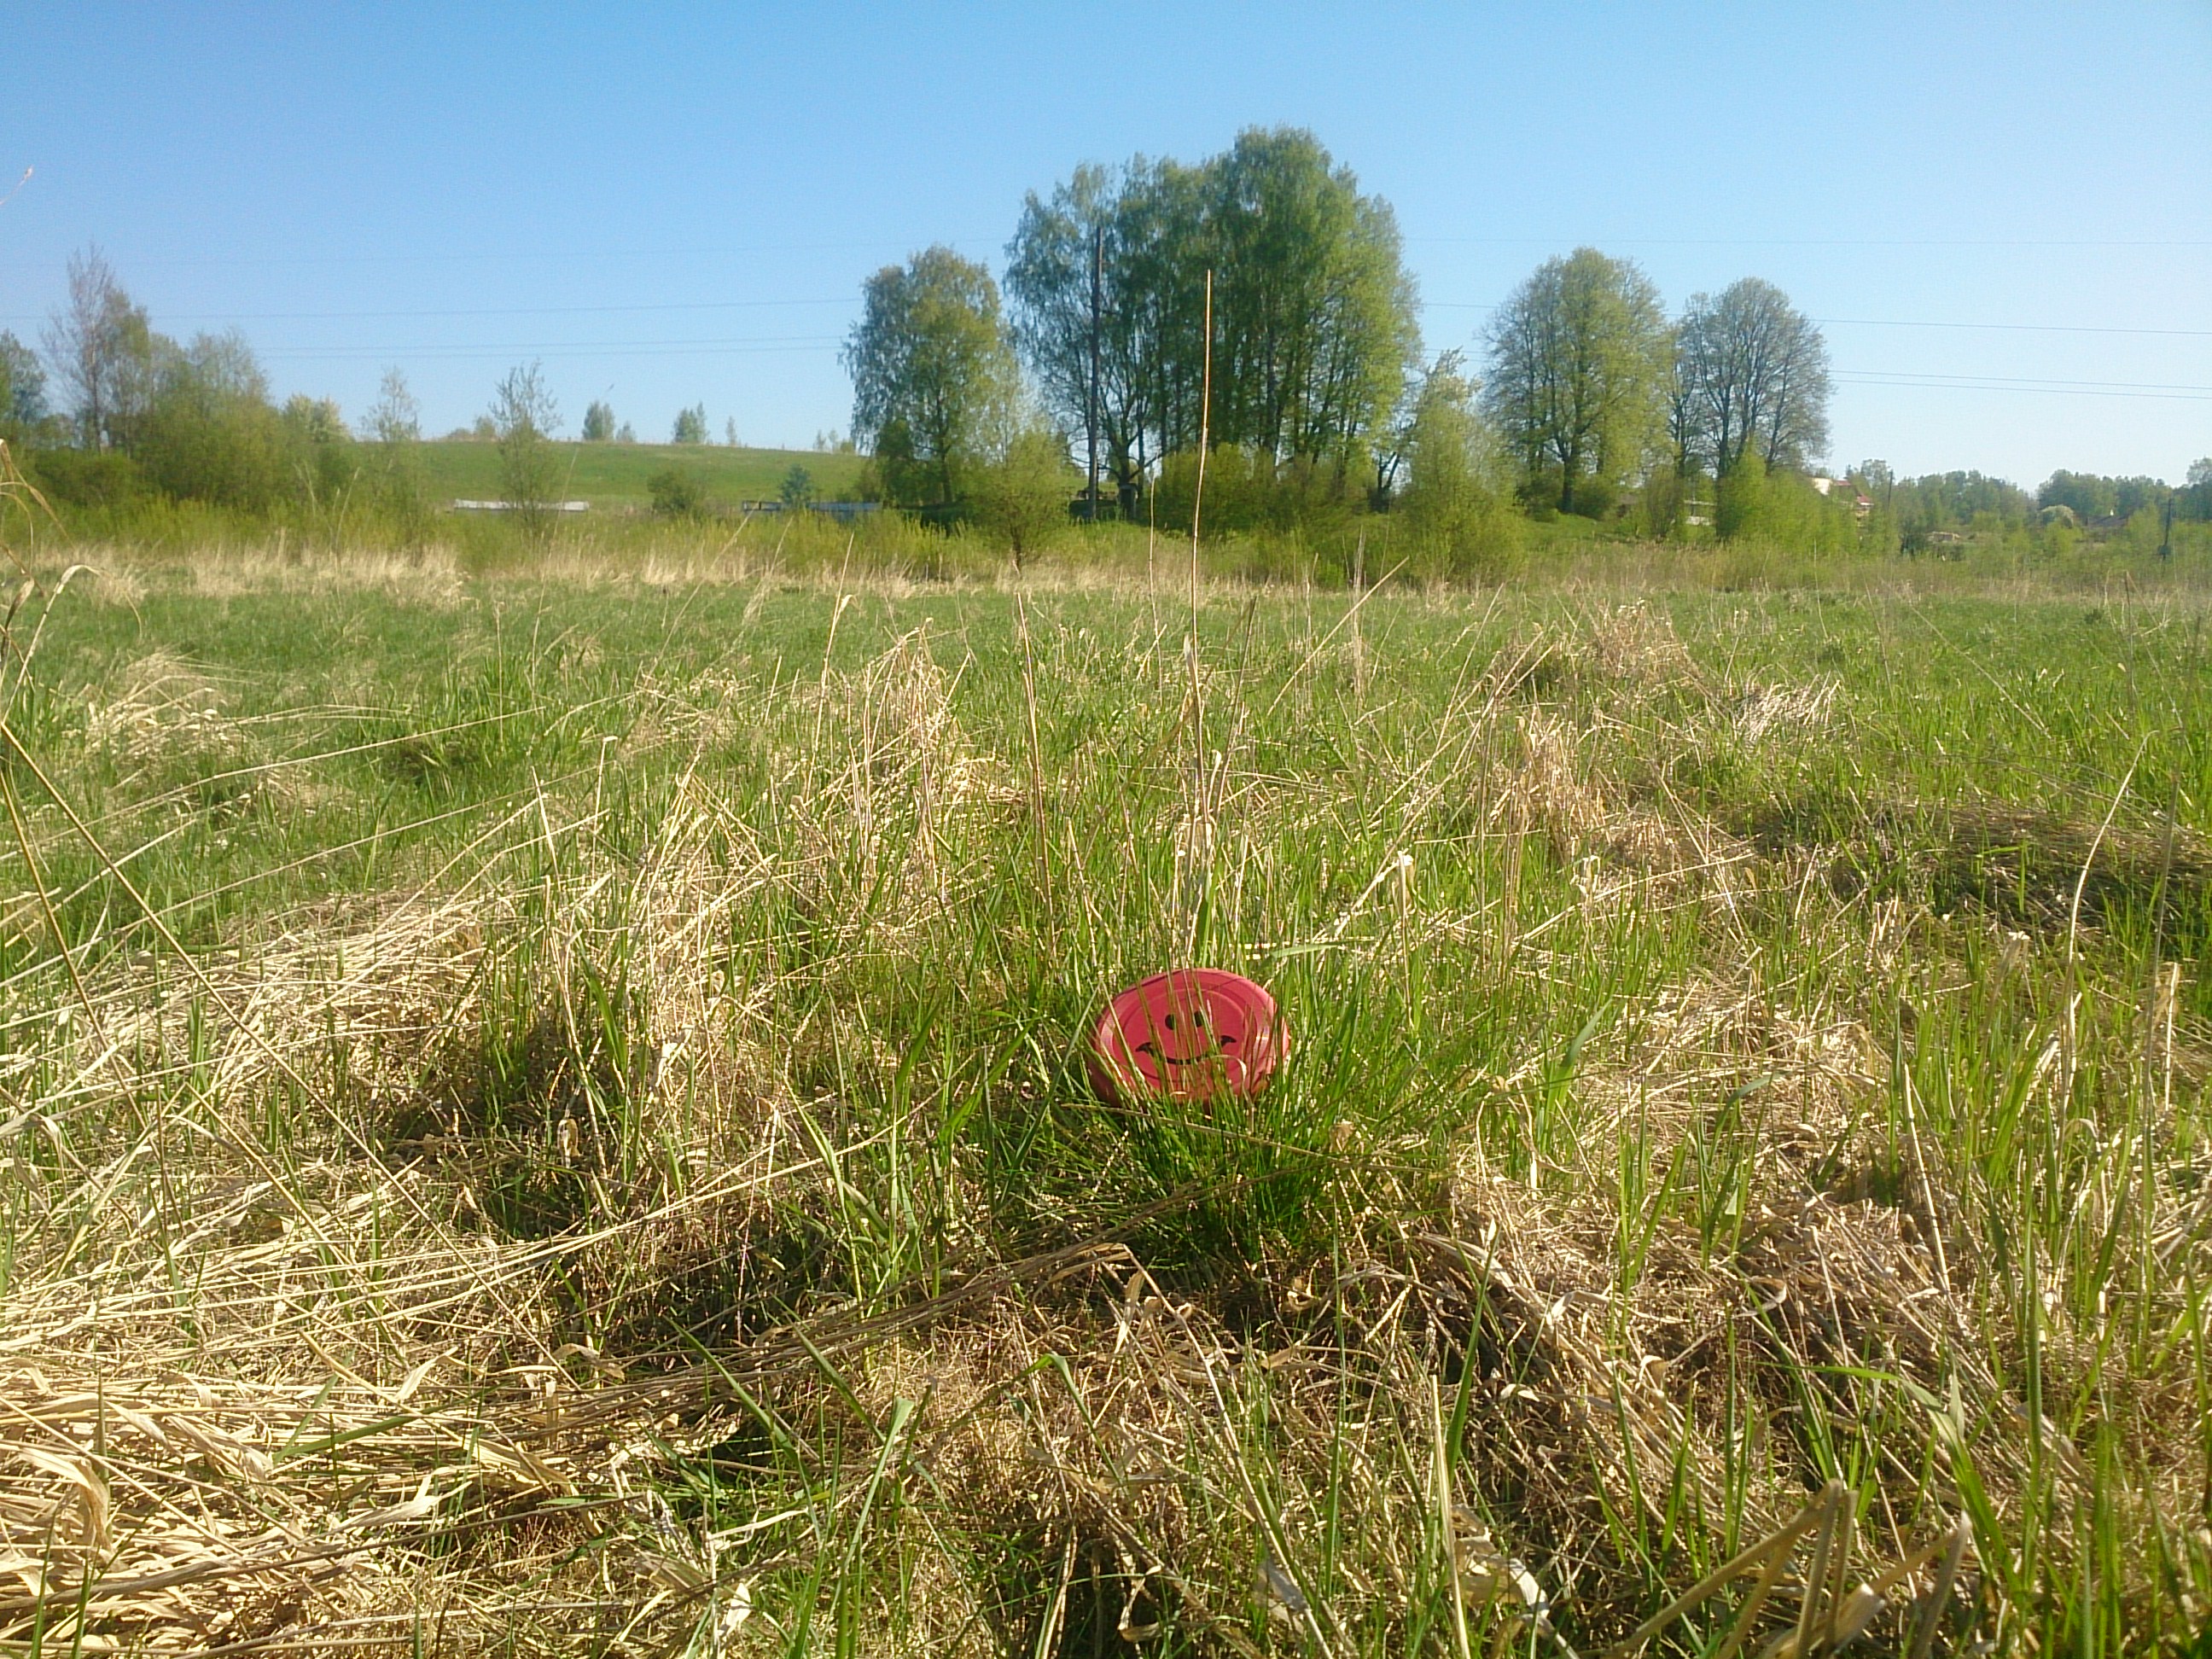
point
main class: Grassland
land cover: Spontaneously vegetated surfaces
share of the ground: > 75 %
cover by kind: herbaceous plants 100 %
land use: Agriculture (excluding fallow land and kitchen gardens)
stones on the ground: < 10 %
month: May
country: LV
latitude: 56.7743
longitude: 24.2771
